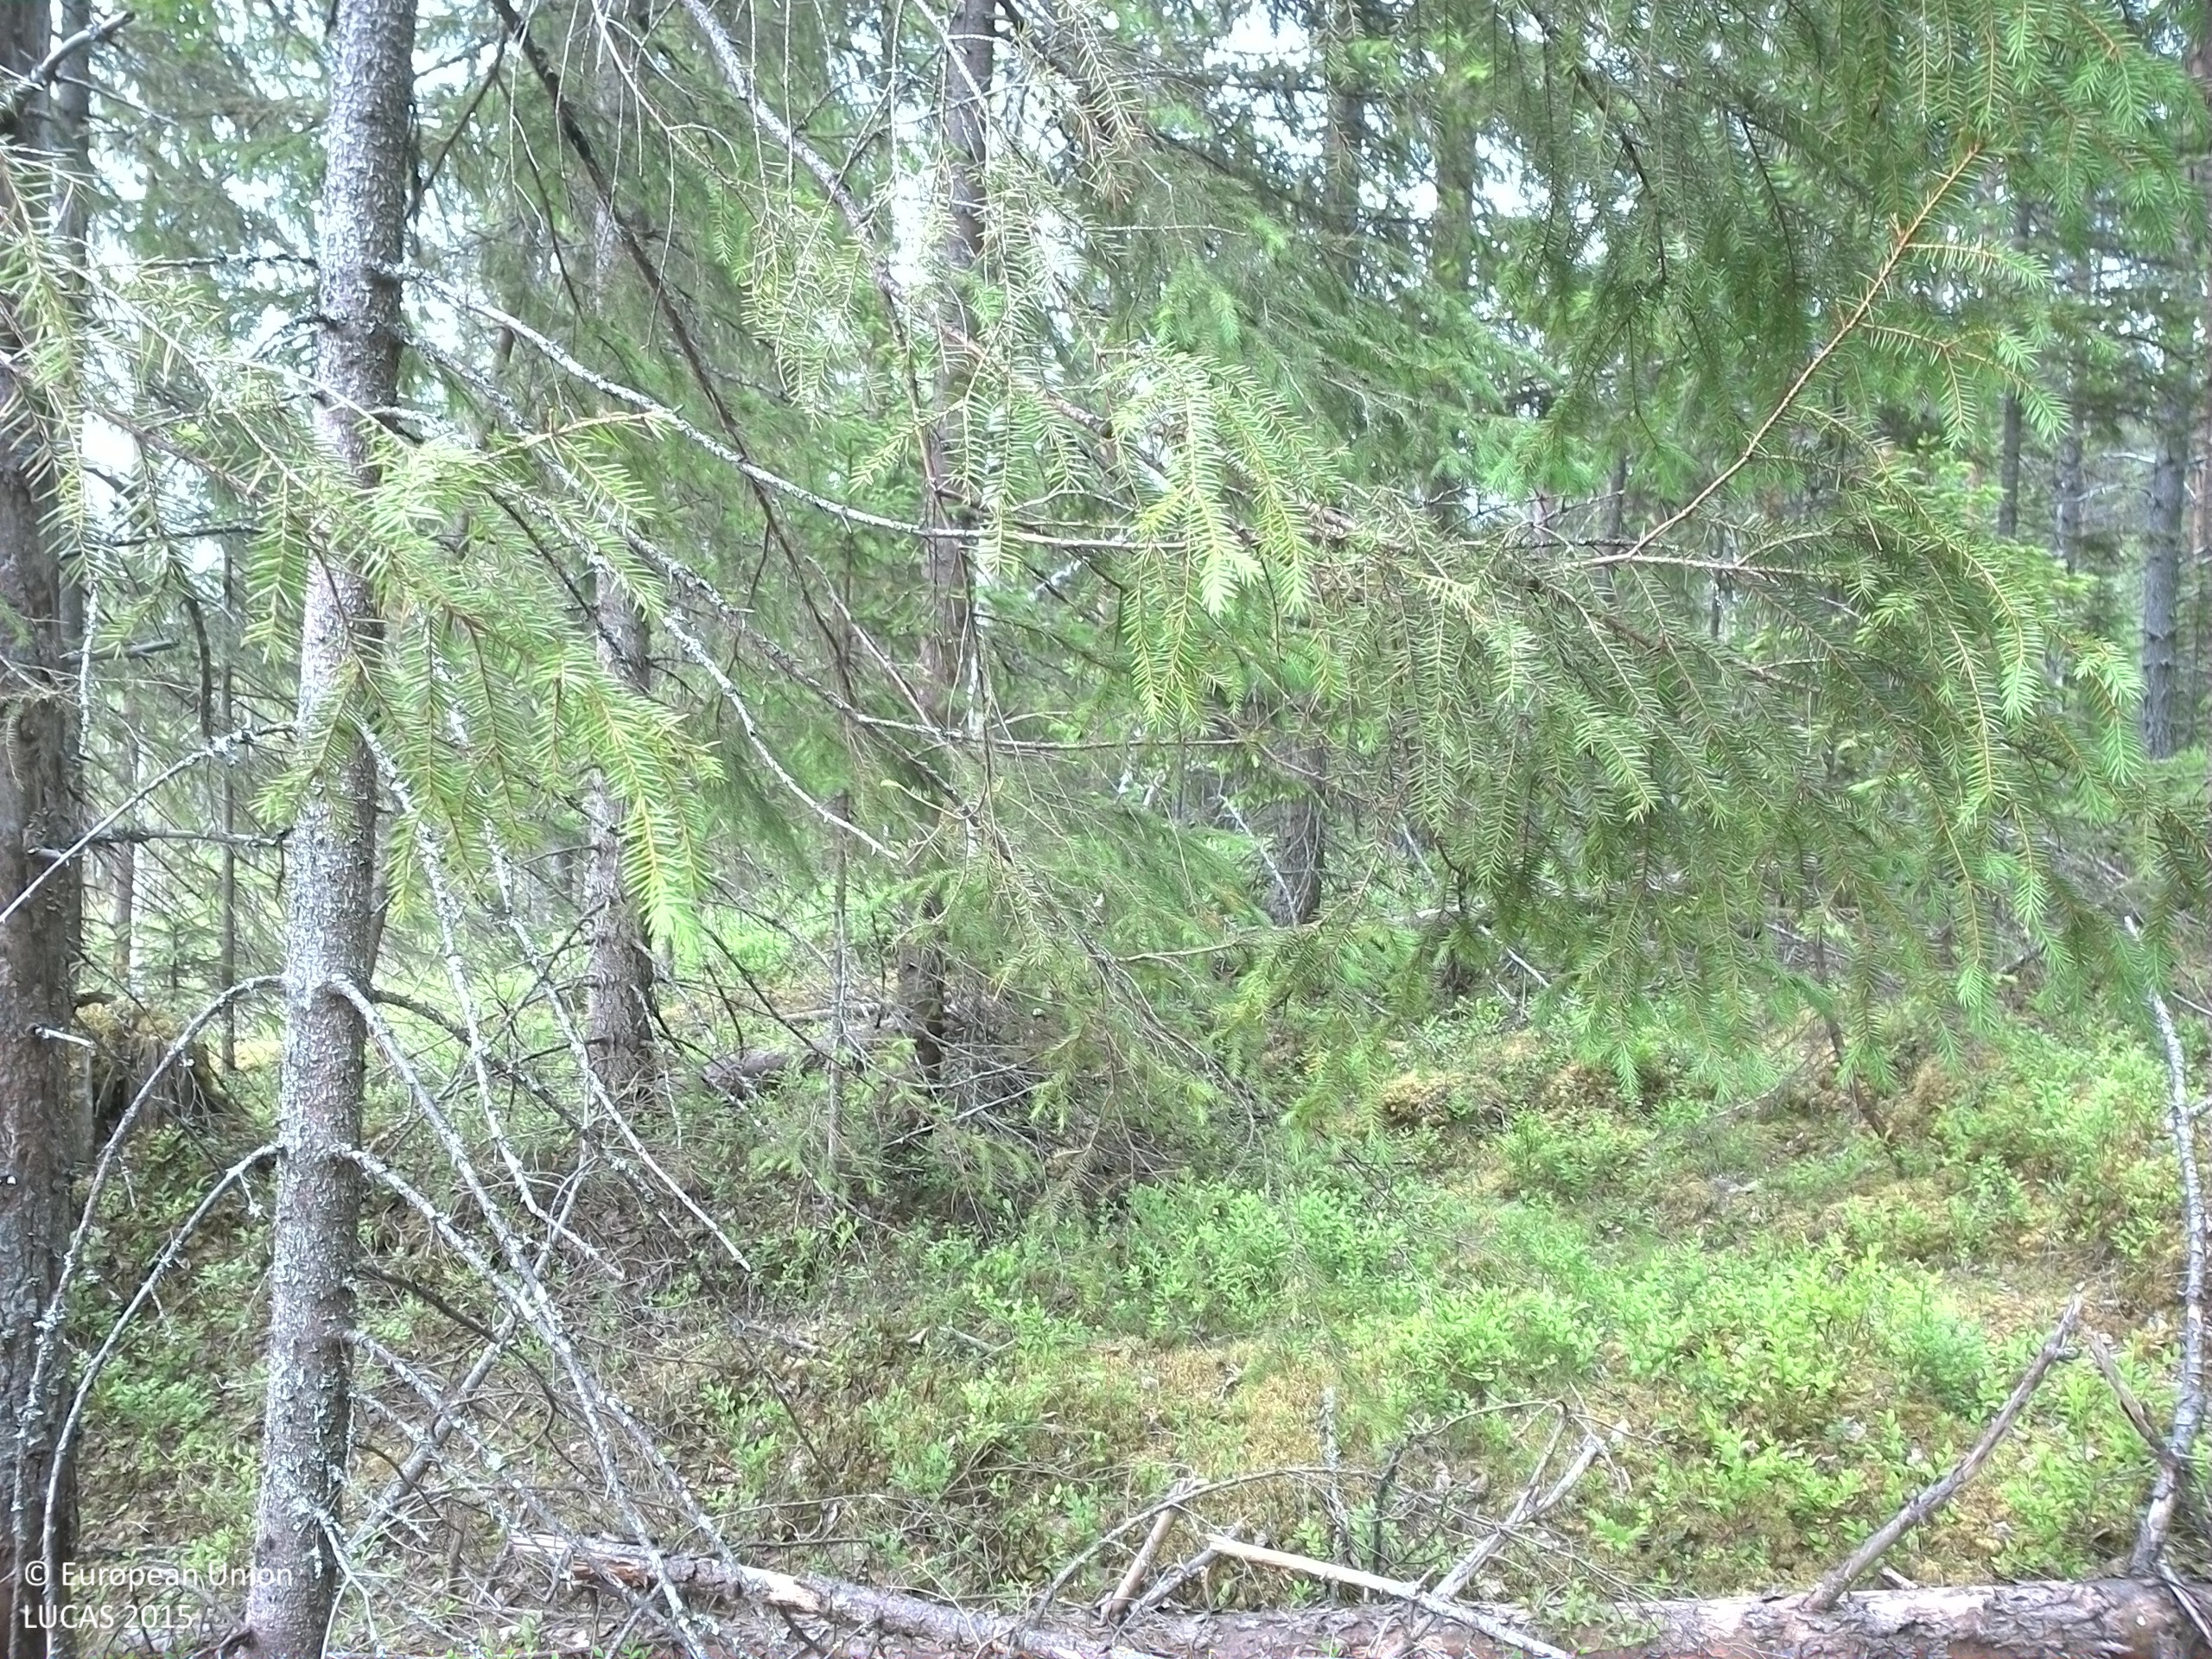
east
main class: Woodland
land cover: Spruce dominated mixed woodland
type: boreal forest
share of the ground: 50 - 75 %
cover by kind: coniferous forest trees 50 %, broadleaved forest trees 20 %, shrubs 20 %, lichens and mosses 10 %
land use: Forestry
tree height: > 5 m
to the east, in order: Spruce dominated mixed woodland; Pine dominated coniferous woodland; Spruce dominated mixed woodland; Tracks; Pine dominated coniferous woodland
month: July
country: SE
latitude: 63.6042
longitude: 17.4934
